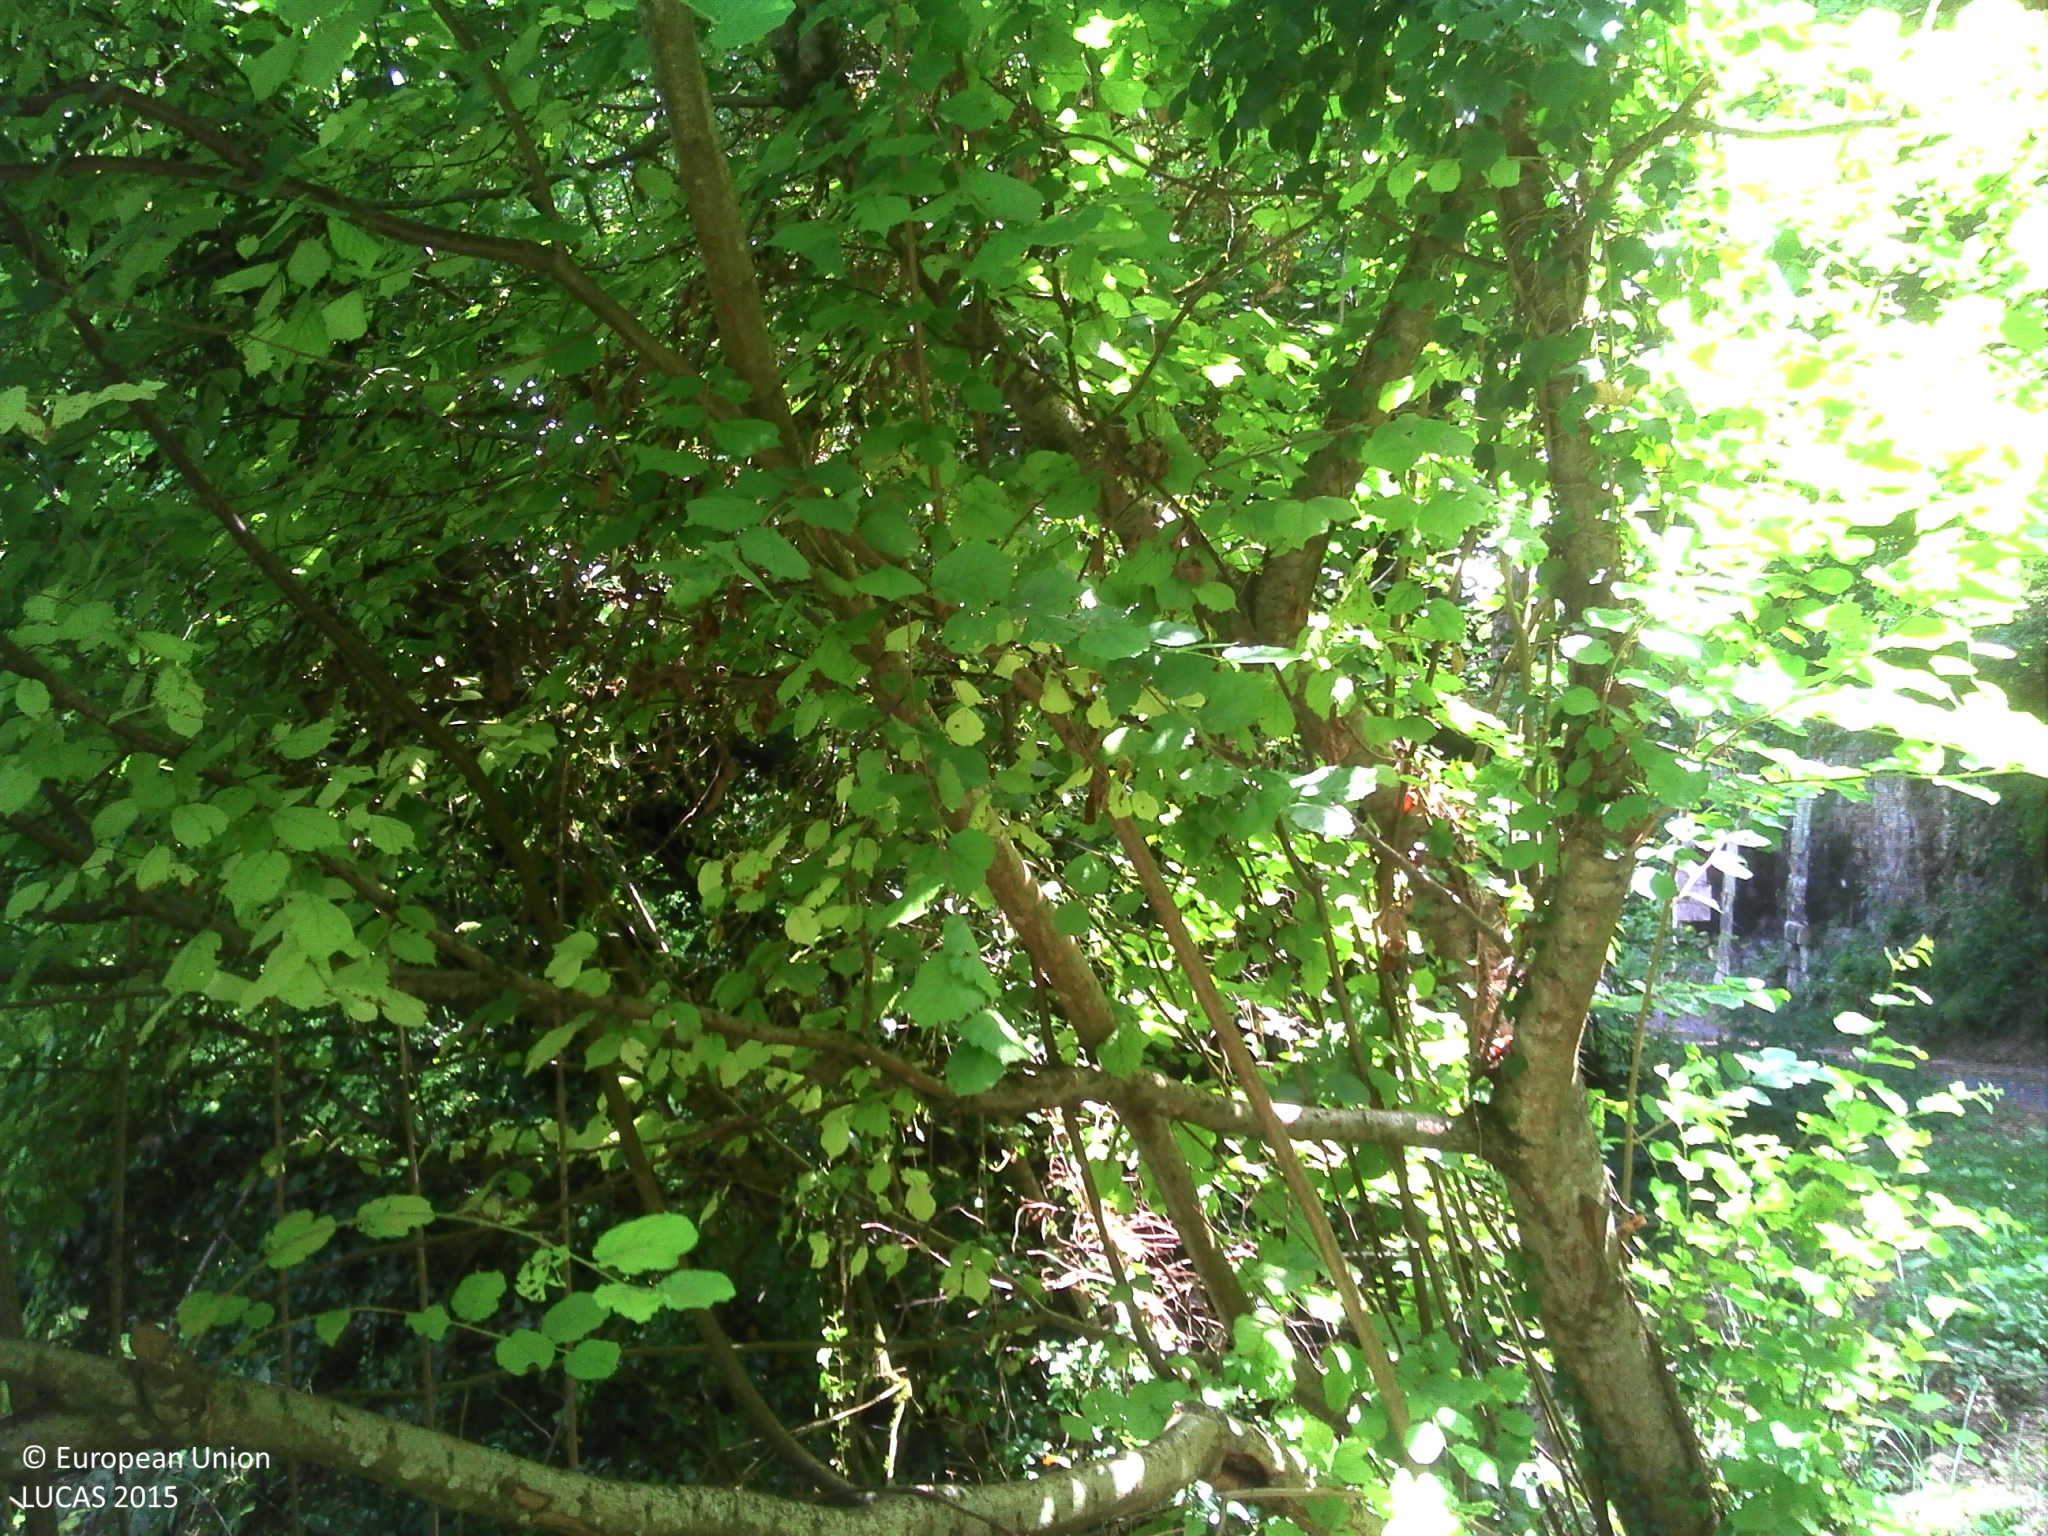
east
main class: Woodland
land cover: Broadleaved woodland
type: mesophytic deciduous forest
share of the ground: > 75 %
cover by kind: broadleaved forest trees 60 %, shrubs 25 %, herbaceous plants 10 %, lichens and mosses 5 %
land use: Forestry
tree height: > 5 m
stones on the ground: 10 - 25 %
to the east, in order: Broadleaved woodland; Grass margins; Tracks; Grass margins; Broadleaved woodland; Grassland without tree/shrub cover
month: August
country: FR
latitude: 47.1649
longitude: 0.1490
